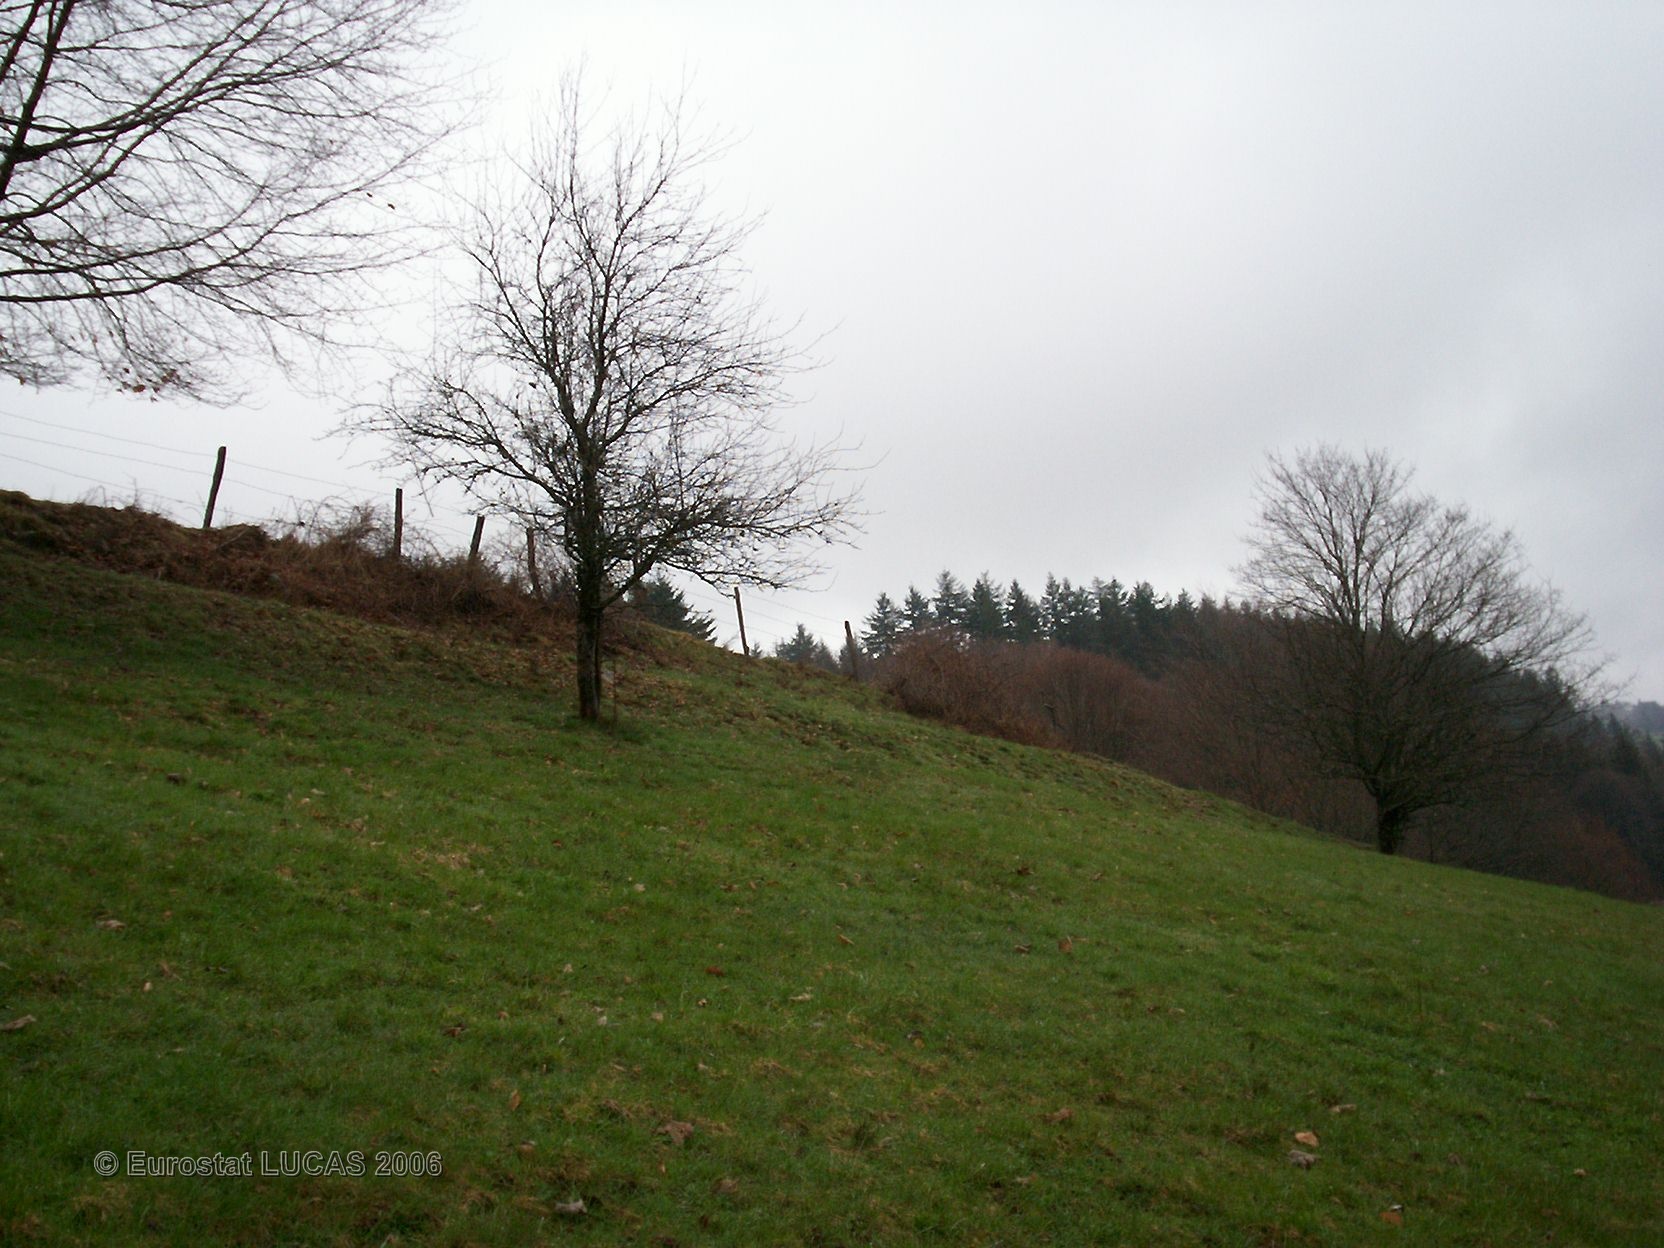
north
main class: Grassland
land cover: Grassland without tree/shrub cover
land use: Agriculture (excluding fallow land and kitchen gardens)
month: April
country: FR
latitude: 47.9358
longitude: 6.5609
